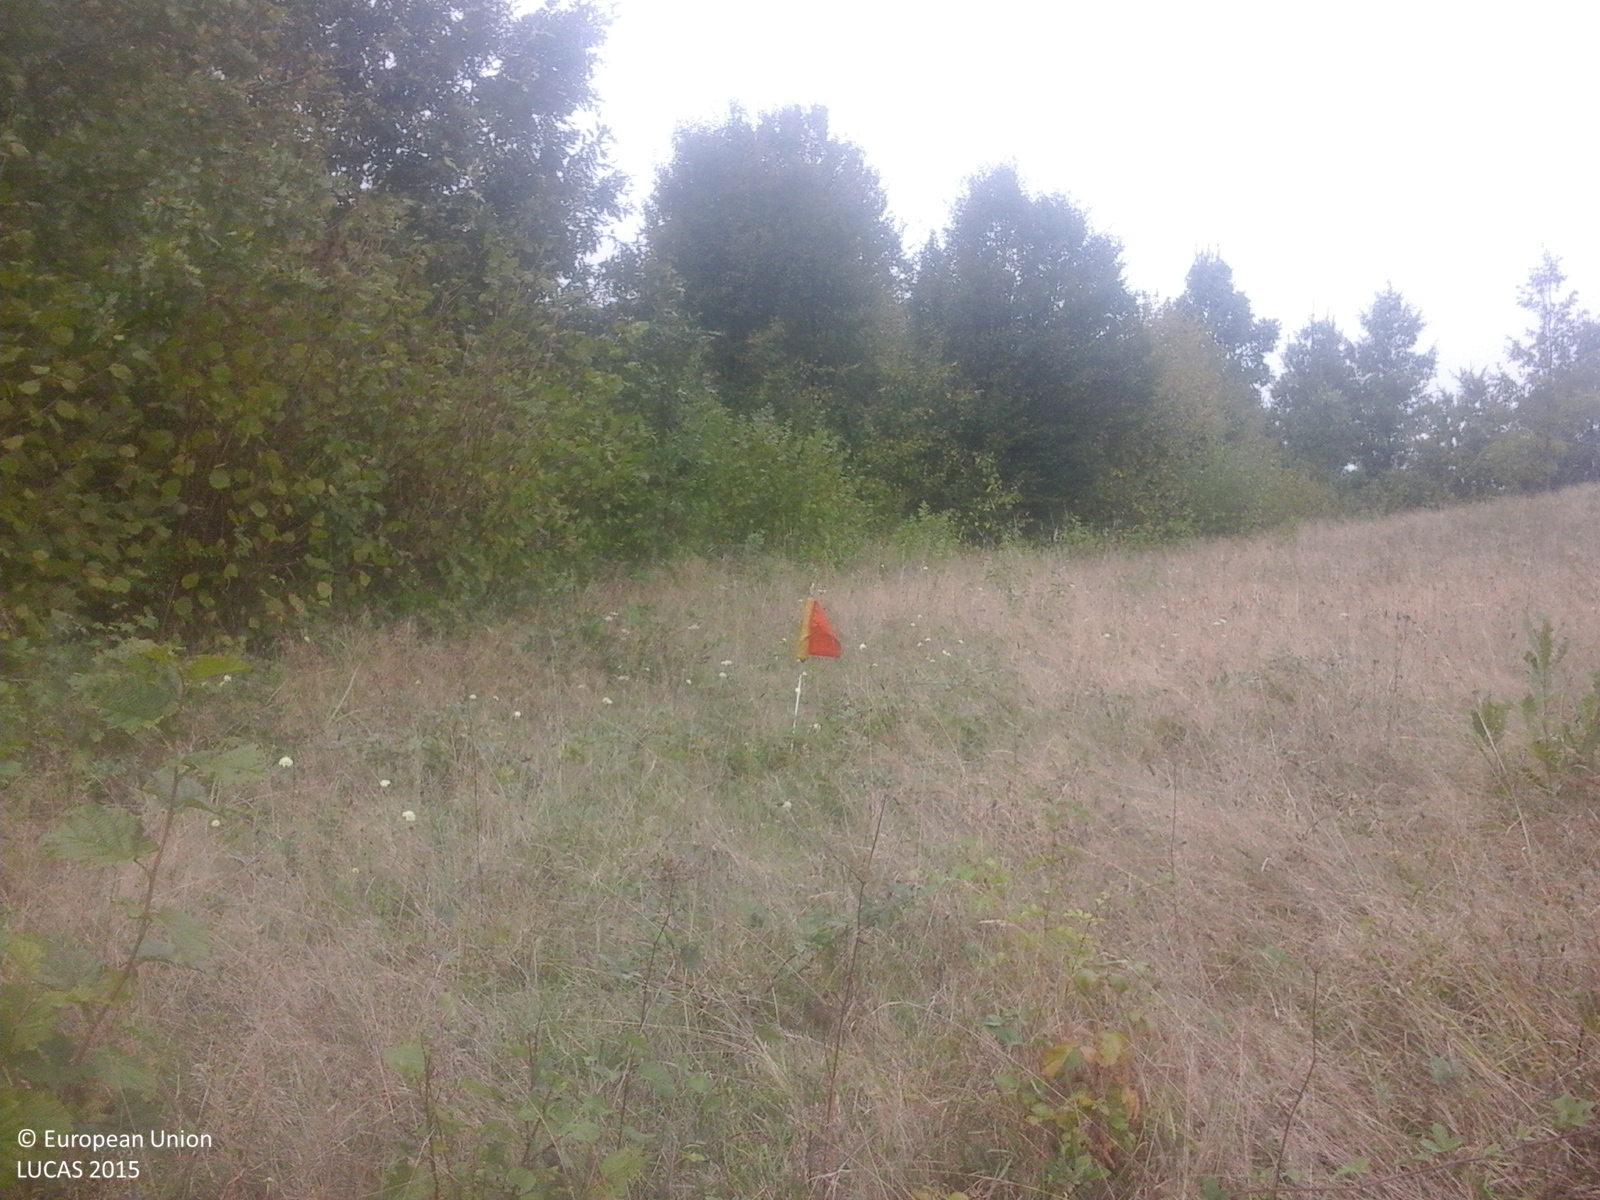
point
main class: Grassland
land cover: Grassland without tree/shrub cover
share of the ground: > 75 %
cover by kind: herbaceous plants 100 %
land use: Agriculture (excluding fallow land and kitchen gardens)
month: September
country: RO
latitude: 45.8663
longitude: 22.0599
